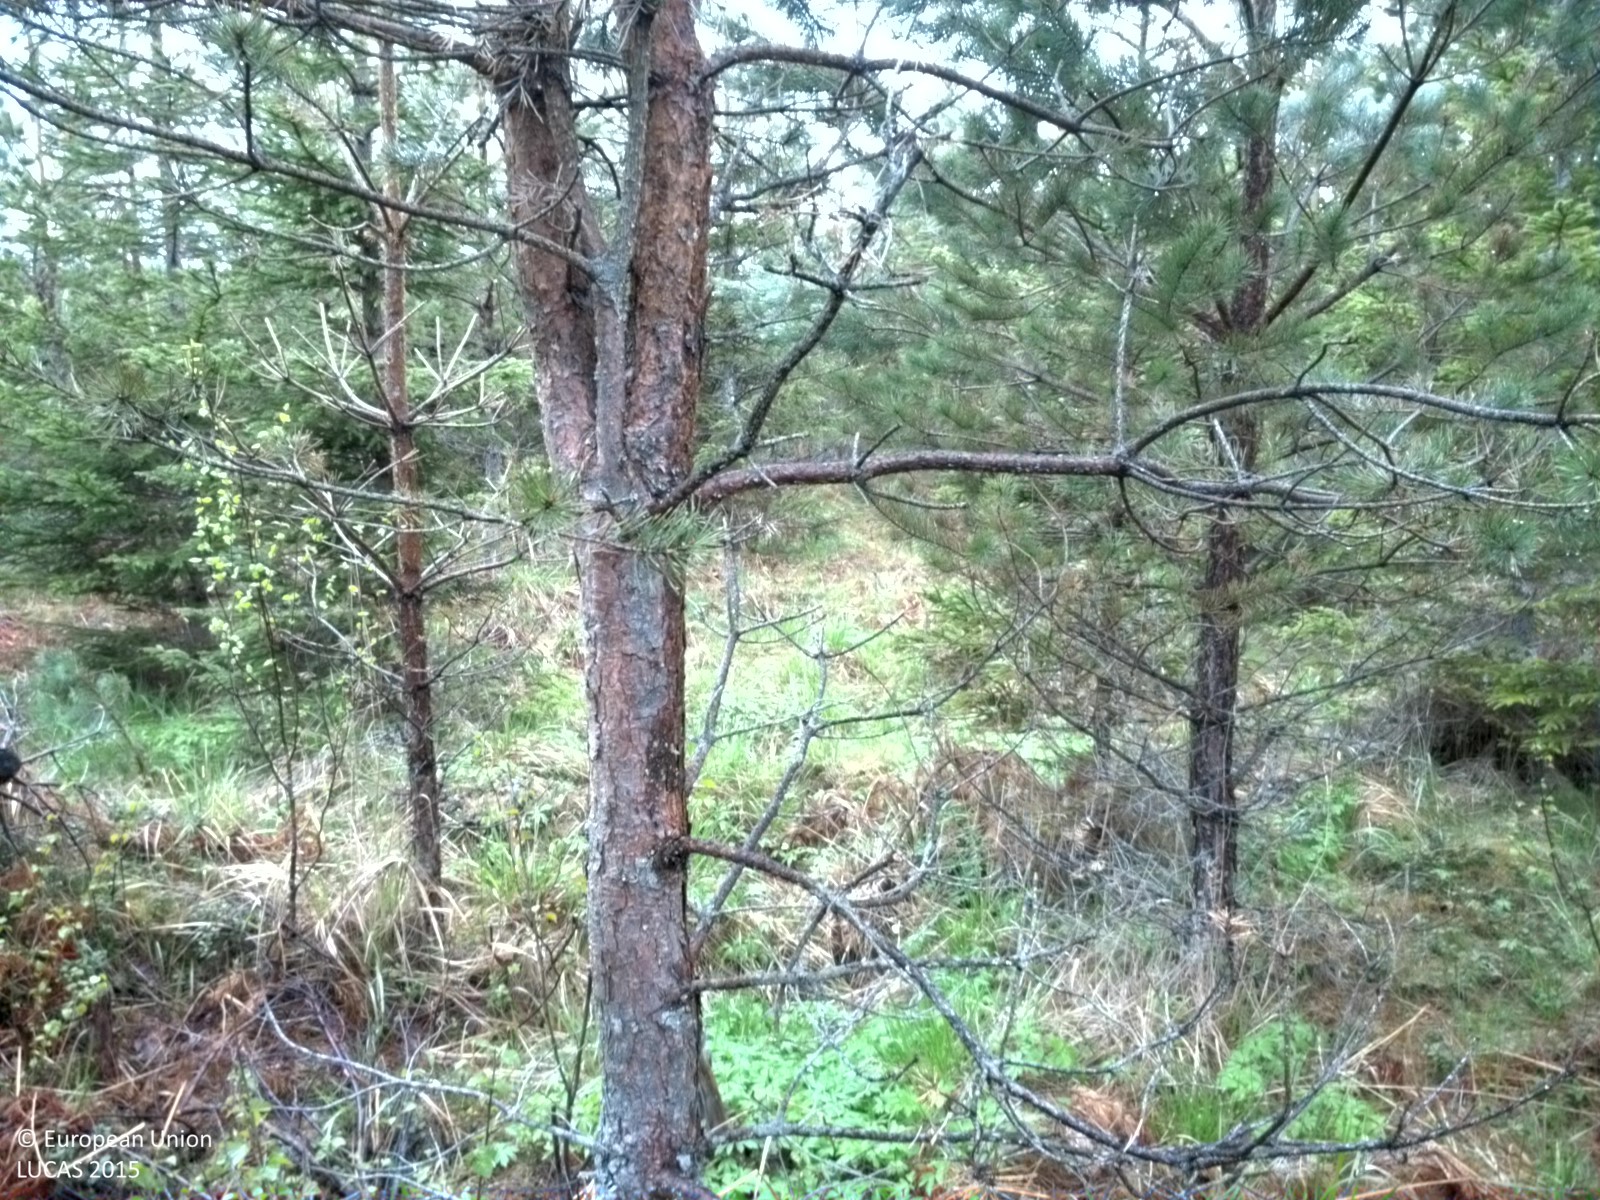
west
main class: Woodland
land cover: Spruce dominated coniferous woodland
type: boreal forest
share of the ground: > 75 %
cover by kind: coniferous forest trees 75 %, broadleaved forest trees 10 %, herbaceous plants 10 %, shrubs 5 %
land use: Forestry
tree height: > 5 m
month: May
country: SE
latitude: 60.2035
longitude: 18.0588
